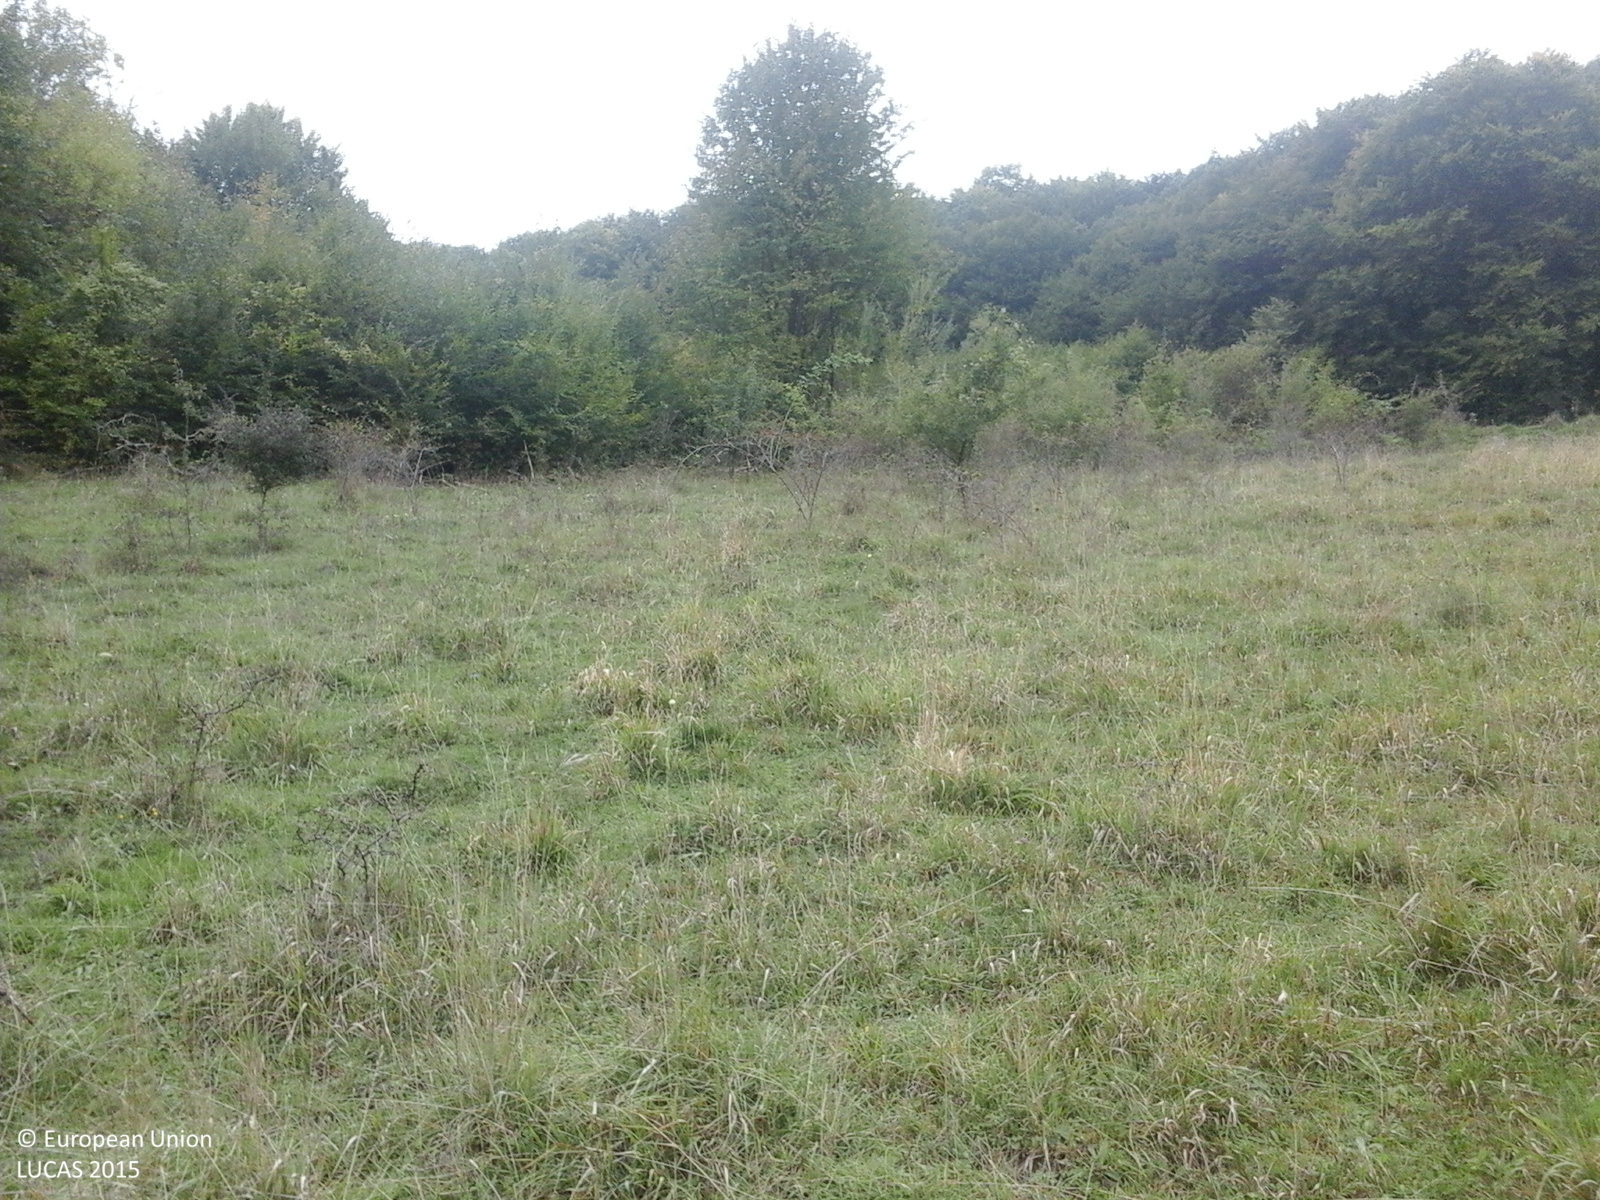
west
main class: Grassland
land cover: Grassland with sparse tree/shrub cover
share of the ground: > 75 %
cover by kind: herbaceous plants 85 %, shrubs 10 %, broadleaved forest trees 5 %
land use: Agriculture (excluding fallow land and kitchen gardens)
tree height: < 5 m
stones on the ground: < 10 %
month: October
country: RO
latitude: 46.0983
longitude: 24.6919
